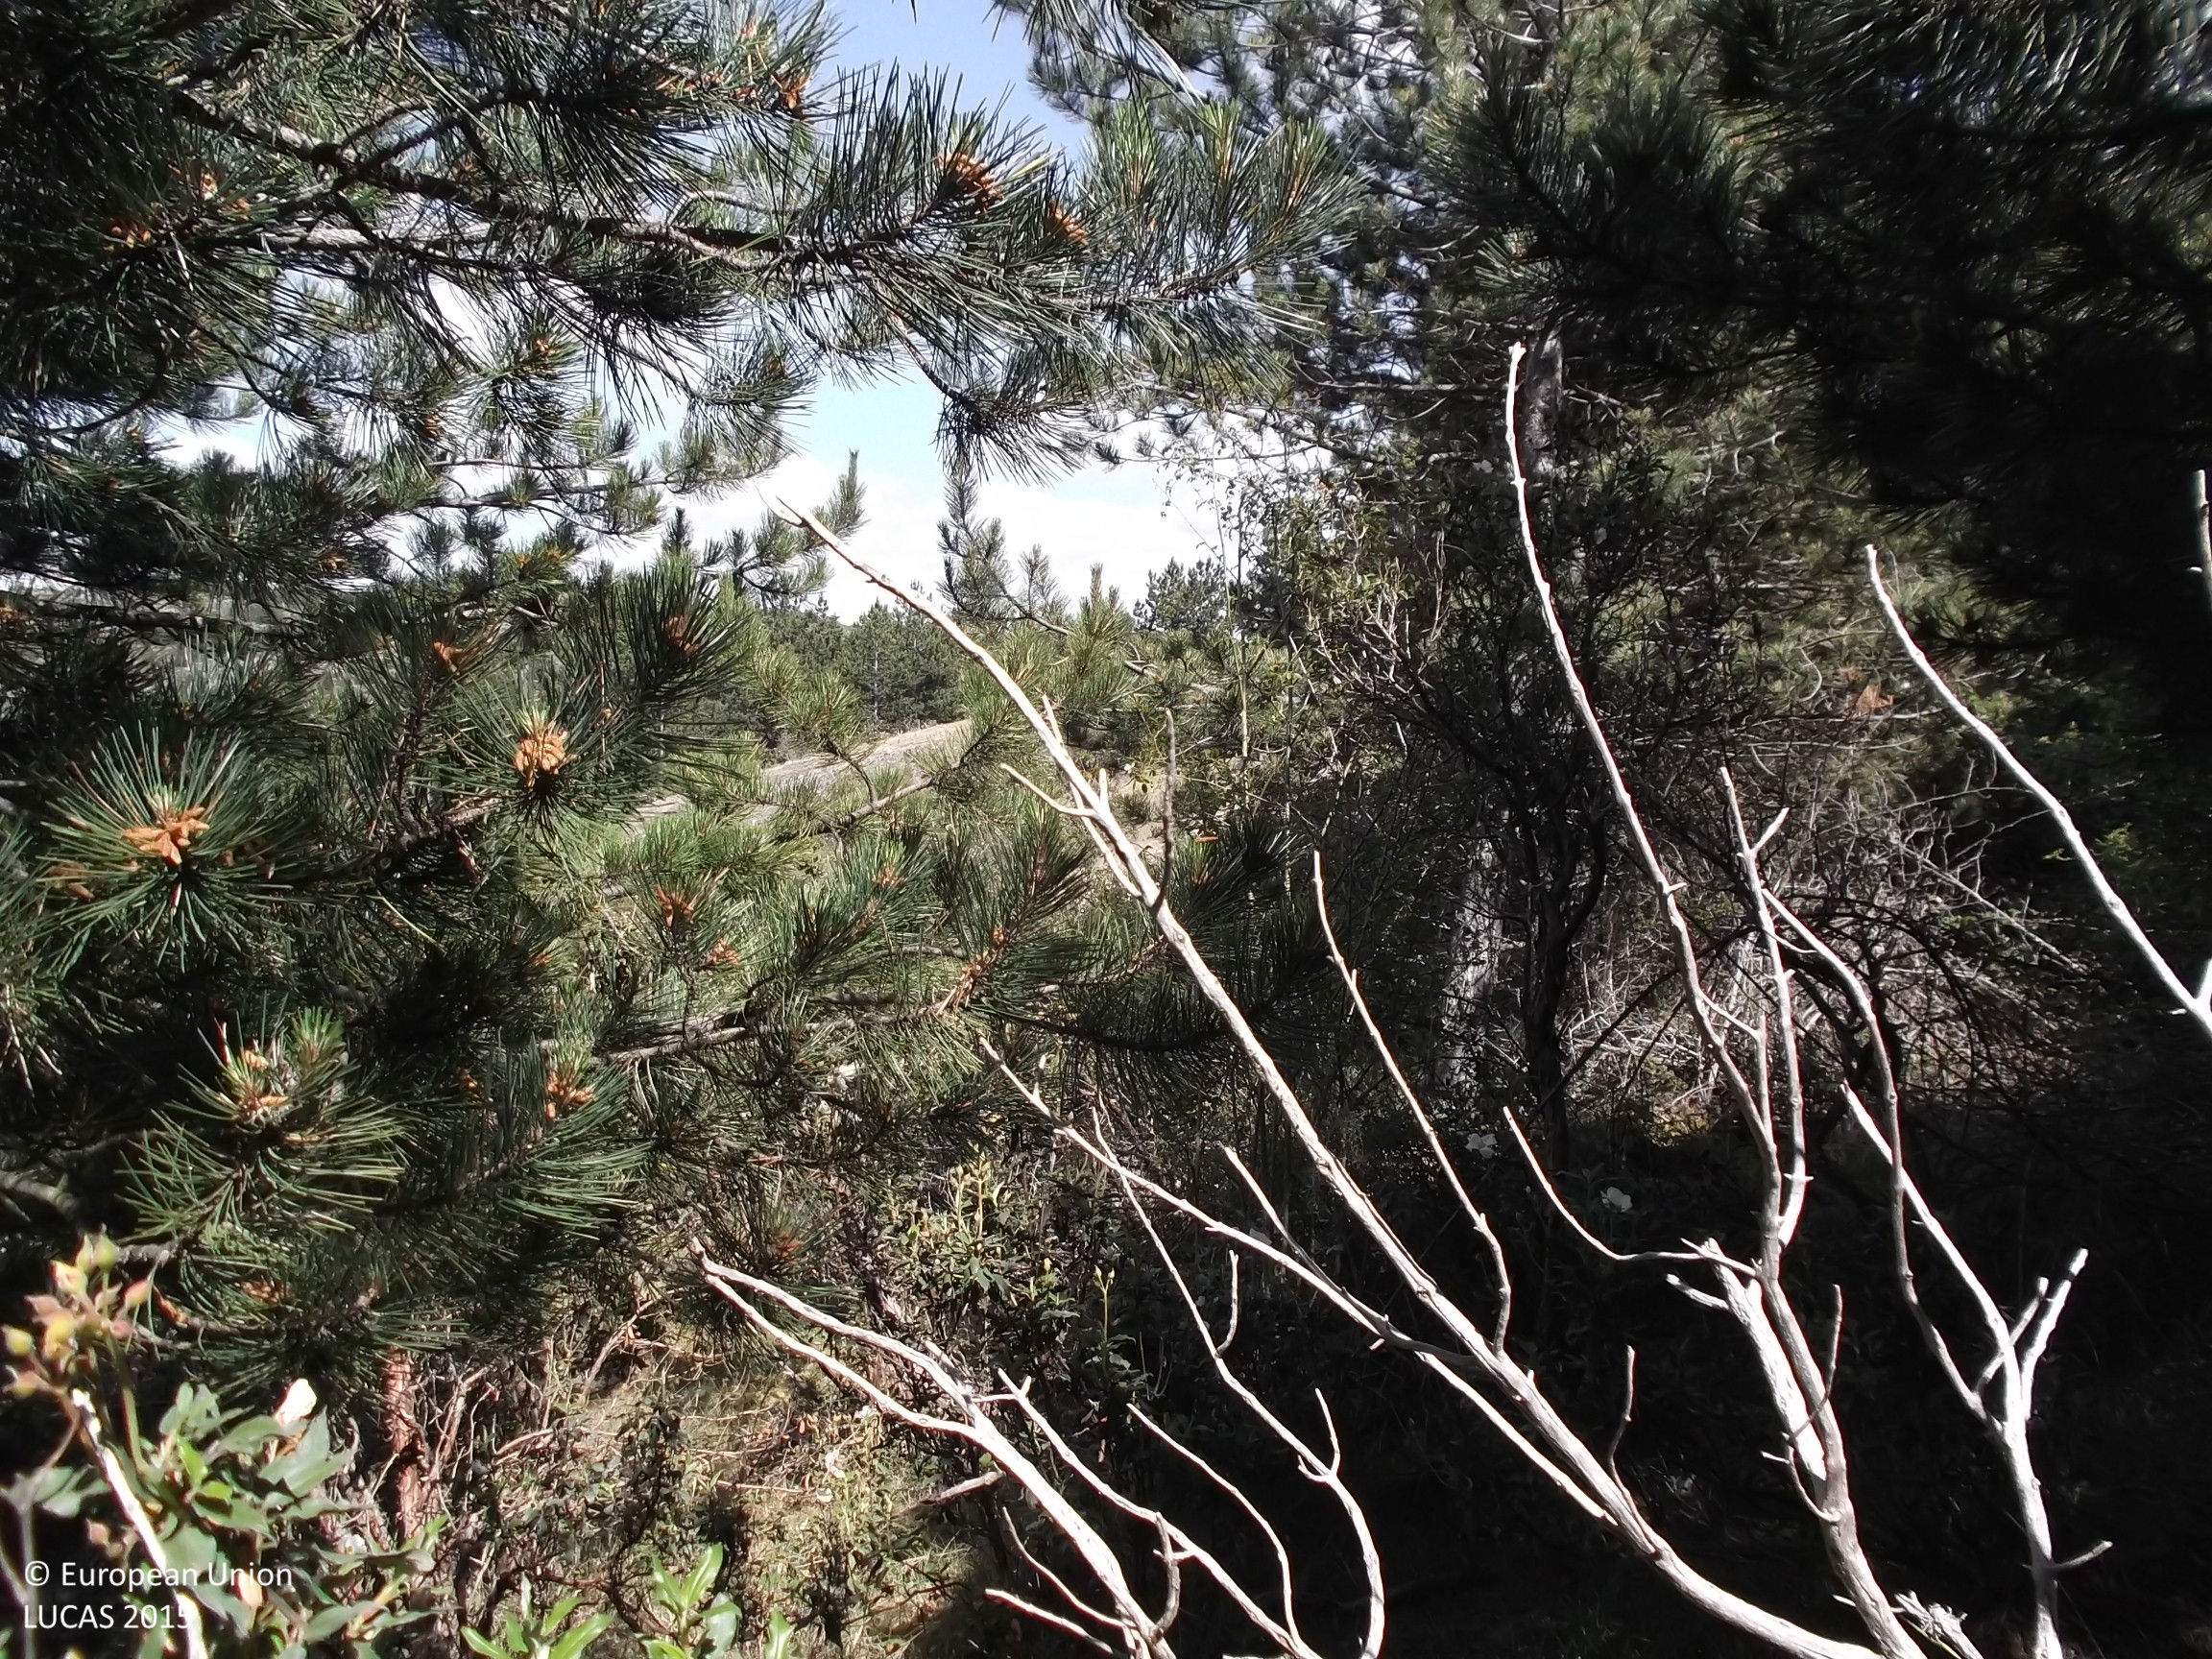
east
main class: Woodland
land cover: Pine dominated coniferous woodland
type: coniferous forest of the mediterranean region
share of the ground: 50 - 75 %
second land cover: Shrubland without tree cover
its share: 50 - 75 %
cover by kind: coniferous forest trees 70 %, shrubs 15 %, unconsolidated bare surface 10 %, herbaceous plants 5 %
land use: Forestry
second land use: Agriculture (excluding fallow land and kitchen gardens)
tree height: > 5 m
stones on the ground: < 10 %
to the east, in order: Pine dominated coniferous woodland; Shrubland without tree cover; Rocks and stones; Shrubland without tree cover; Pine dominated coniferous woodland; Shrubland without tree cover; Pine dominated coniferous woodland; Shrubland without tree cover; Pine dominated coniferous woodland
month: June
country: ES
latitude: 42.2101
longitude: -2.3109
